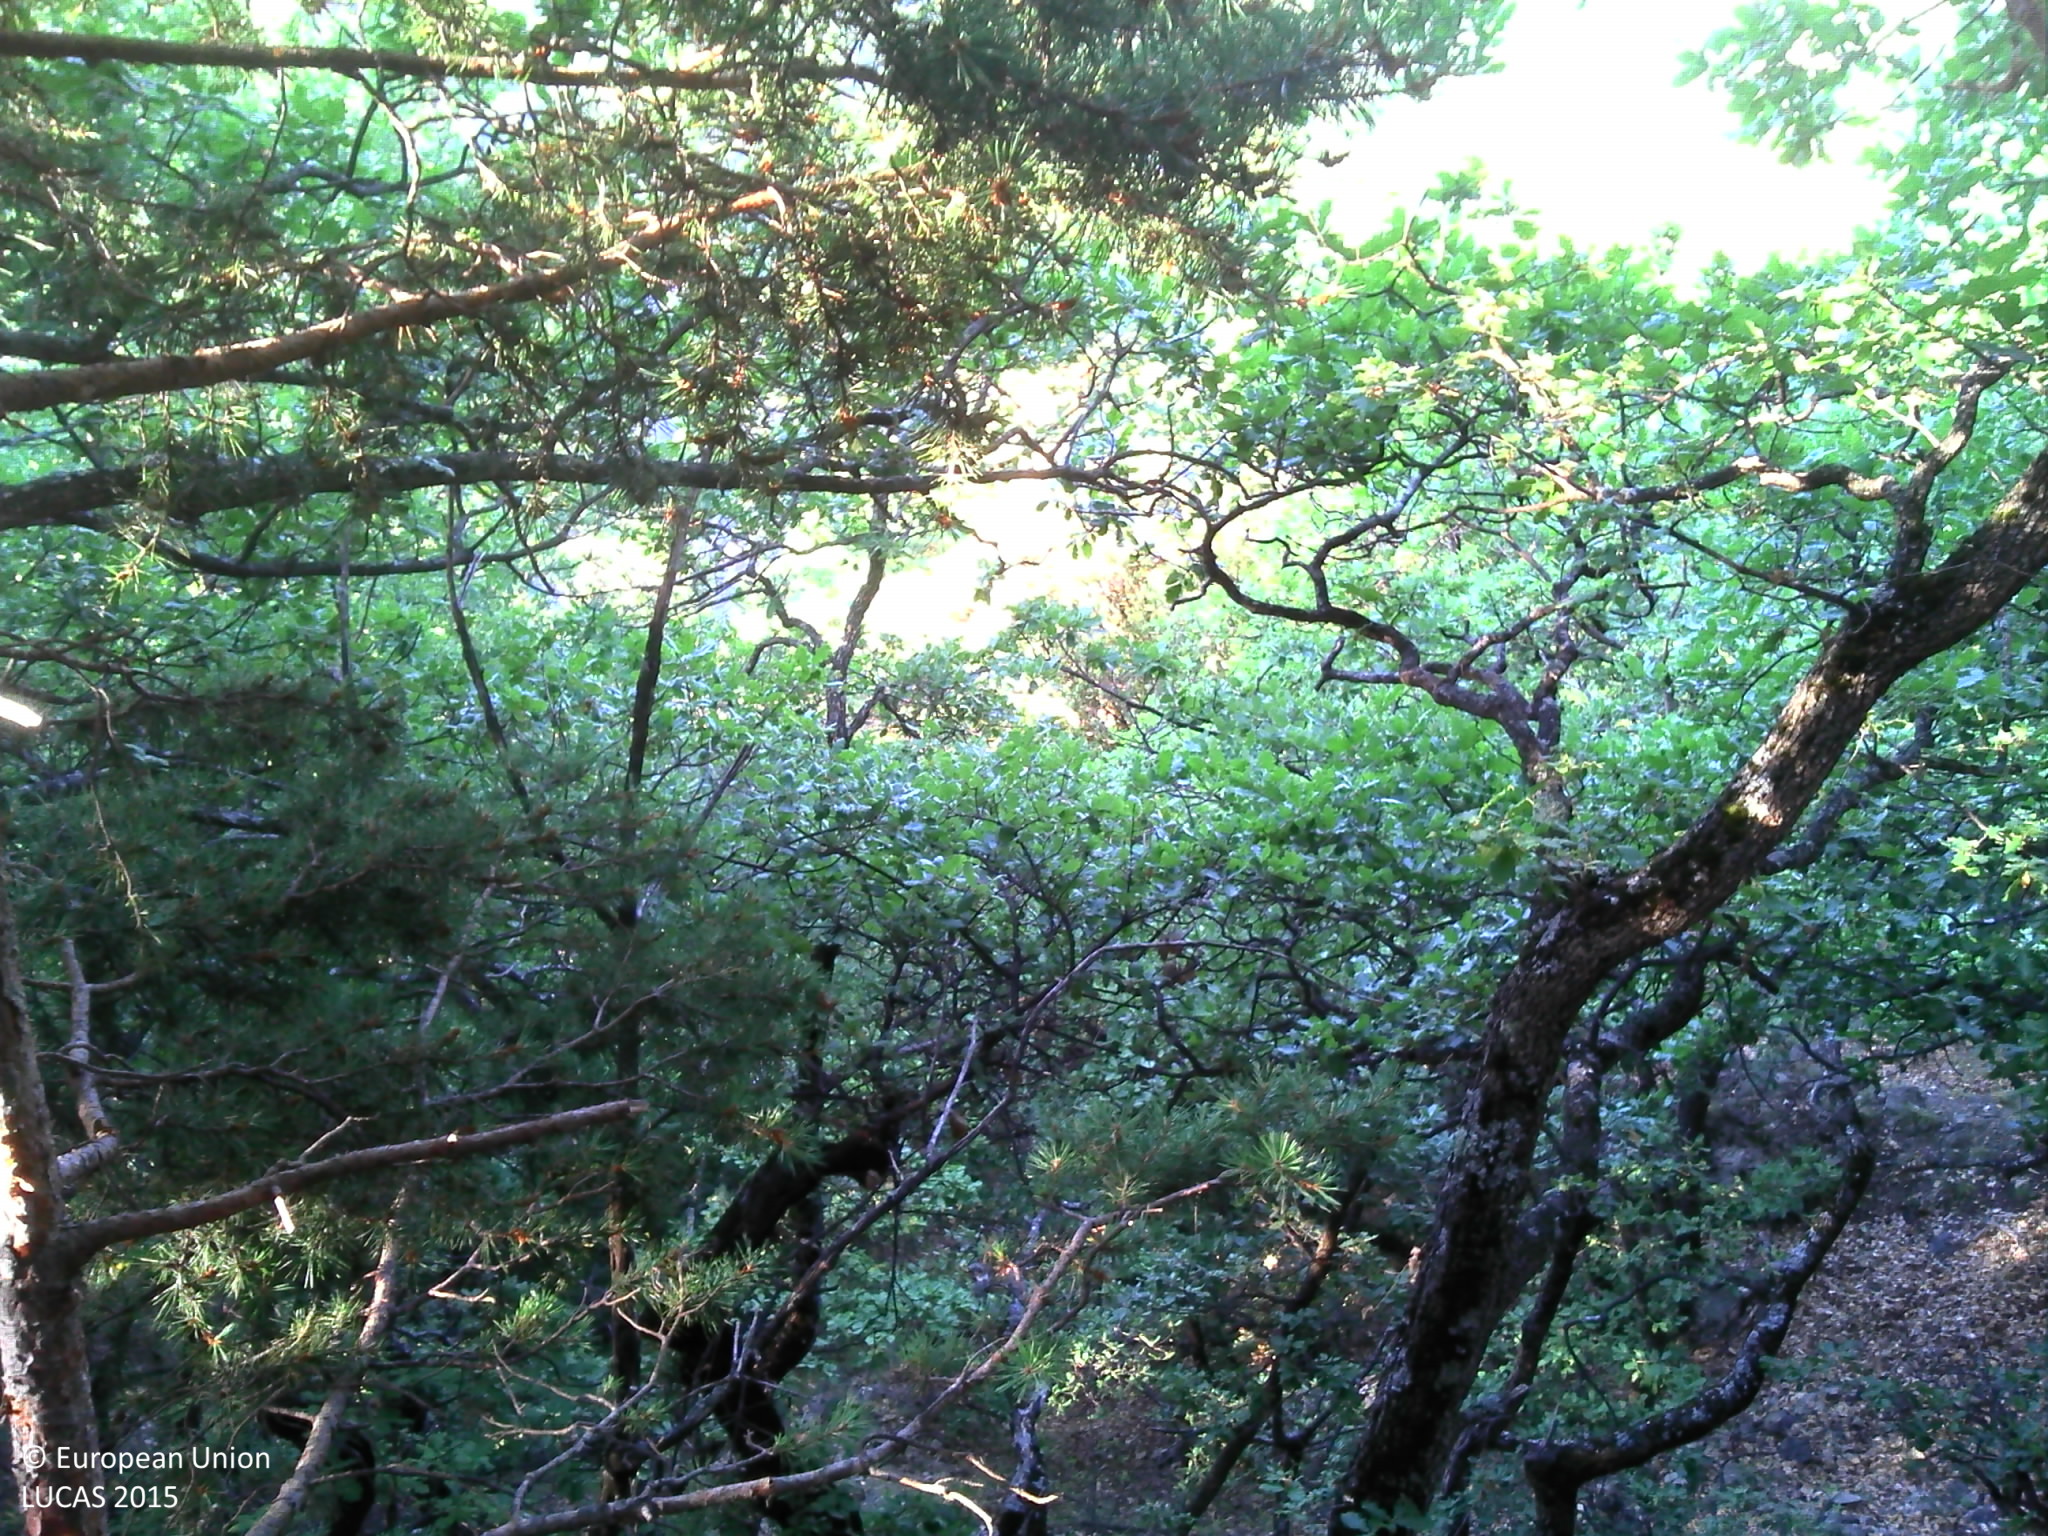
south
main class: Woodland
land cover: Pine dominated mixed woodland
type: mesophytic deciduous forest
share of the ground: > 75 %
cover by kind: broadleaved forest trees 55 %, coniferous forest trees 40 %, unconsolidated bare surface 5 %
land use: Semi-natural and natural areas not in use
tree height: > 5 m
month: July
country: FR
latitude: 42.5150
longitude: 2.1851
